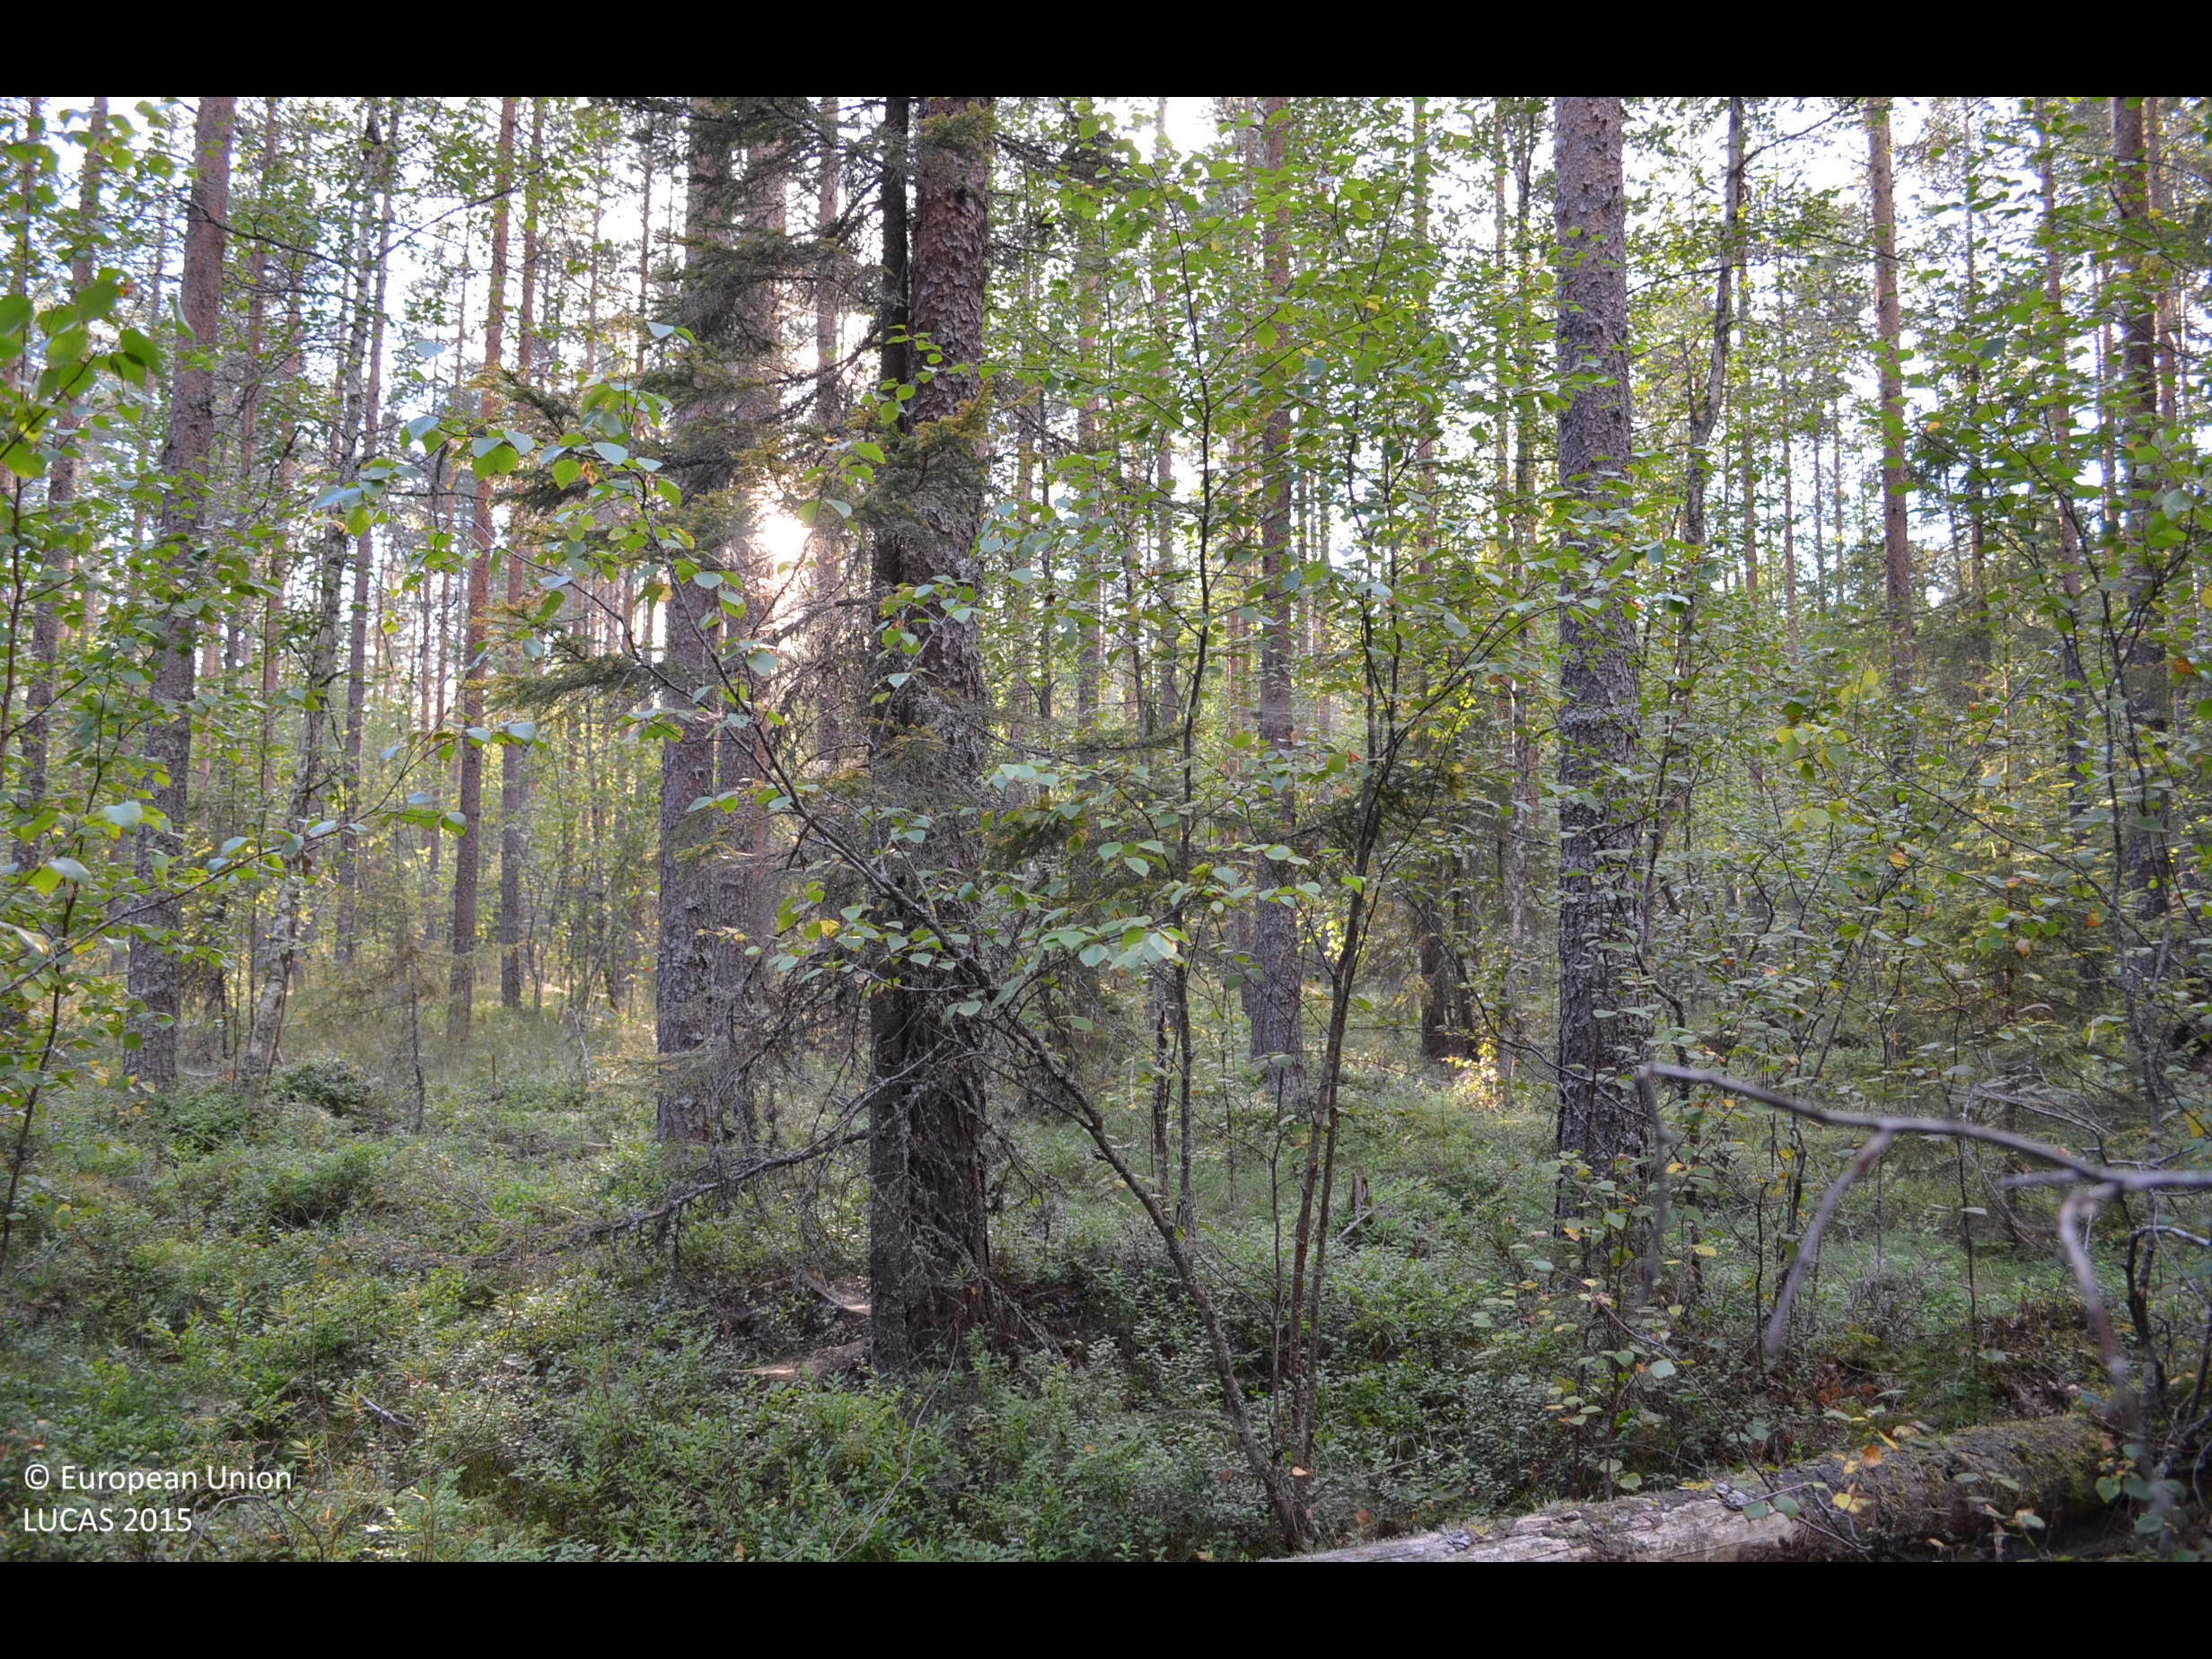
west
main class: Woodland
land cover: Pine dominated mixed woodland
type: boreal forest
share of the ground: > 75 %
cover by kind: coniferous forest trees 60 %, broadleaved forest trees 25 %, shrubs 10 %, herbaceous plants 5 %
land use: Forestry
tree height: > 5 m
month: August
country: FI
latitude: 62.4086
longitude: 24.4300
